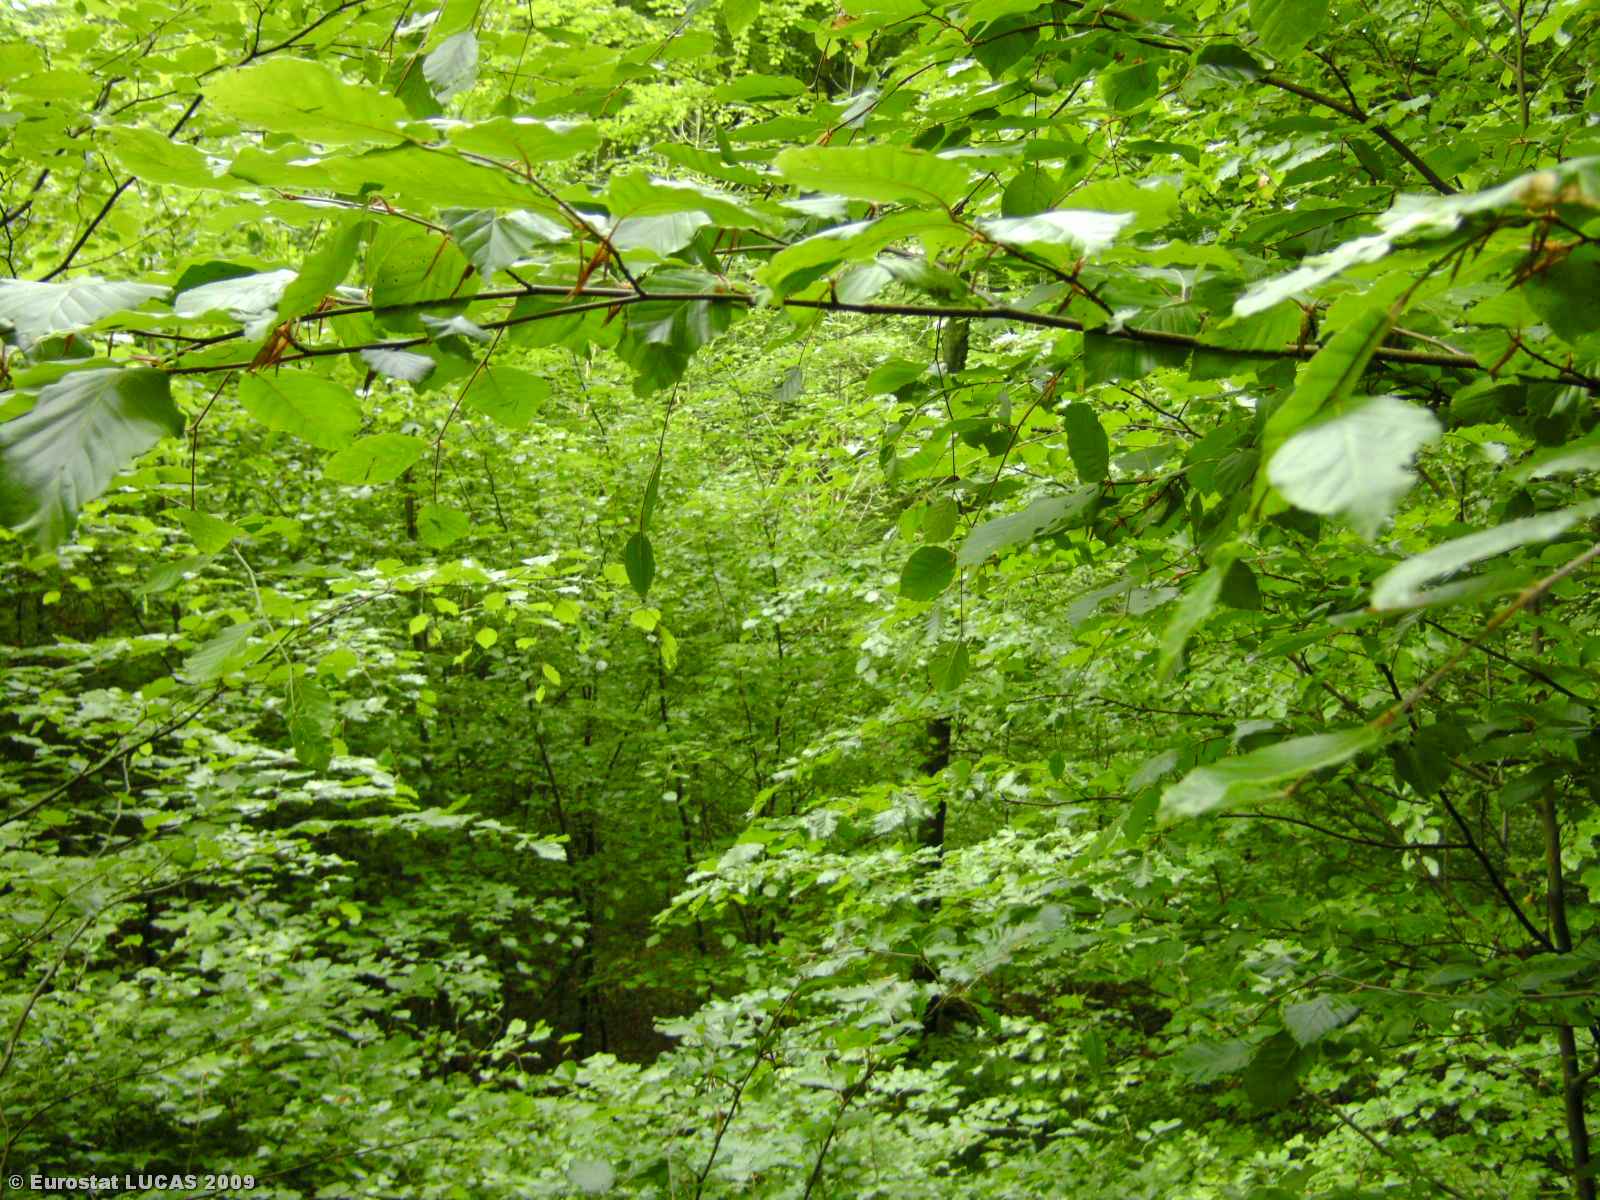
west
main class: Woodland
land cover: Broadleaved woodland
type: beech forest
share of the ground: 50 - 75 %
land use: Forestry
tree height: > 5 m
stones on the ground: < 10 %
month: May
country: LU
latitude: 49.8302
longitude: 6.1207
